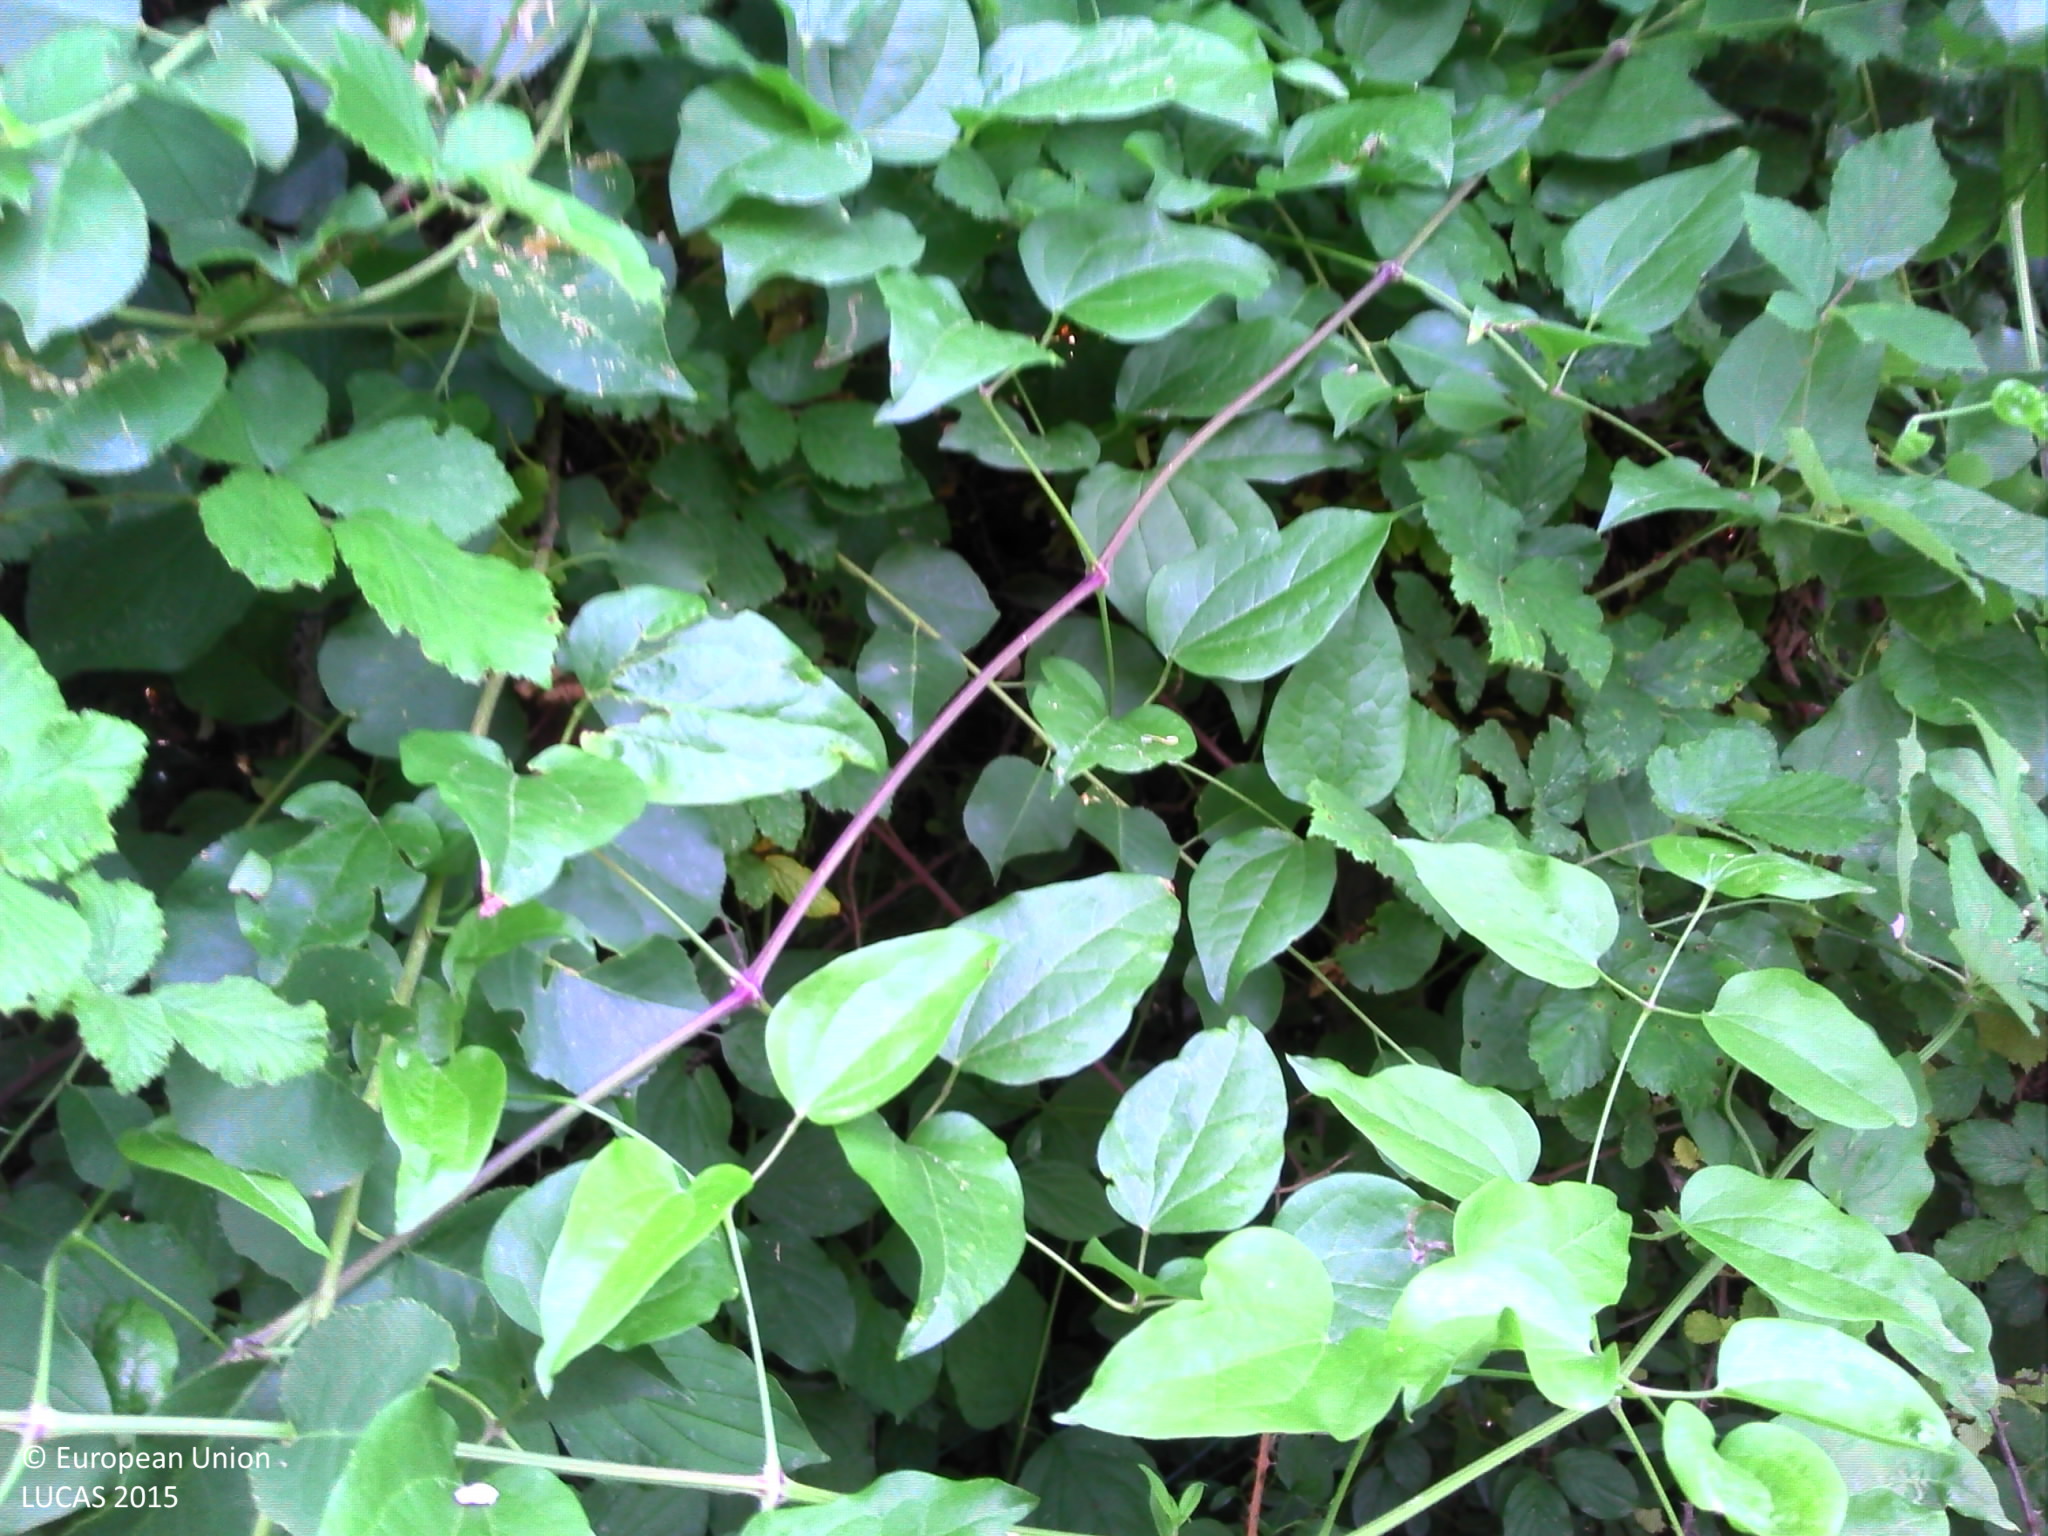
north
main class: Grassland
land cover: Grassland with sparse tree/shrub cover
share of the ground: > 75 %
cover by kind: herbaceous plants 90 %, broadleaved forest trees 5 %, shrubs 5 %
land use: Residential
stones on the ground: 25 - 50 %
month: June
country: FR
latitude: 44.7151
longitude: 4.9443
